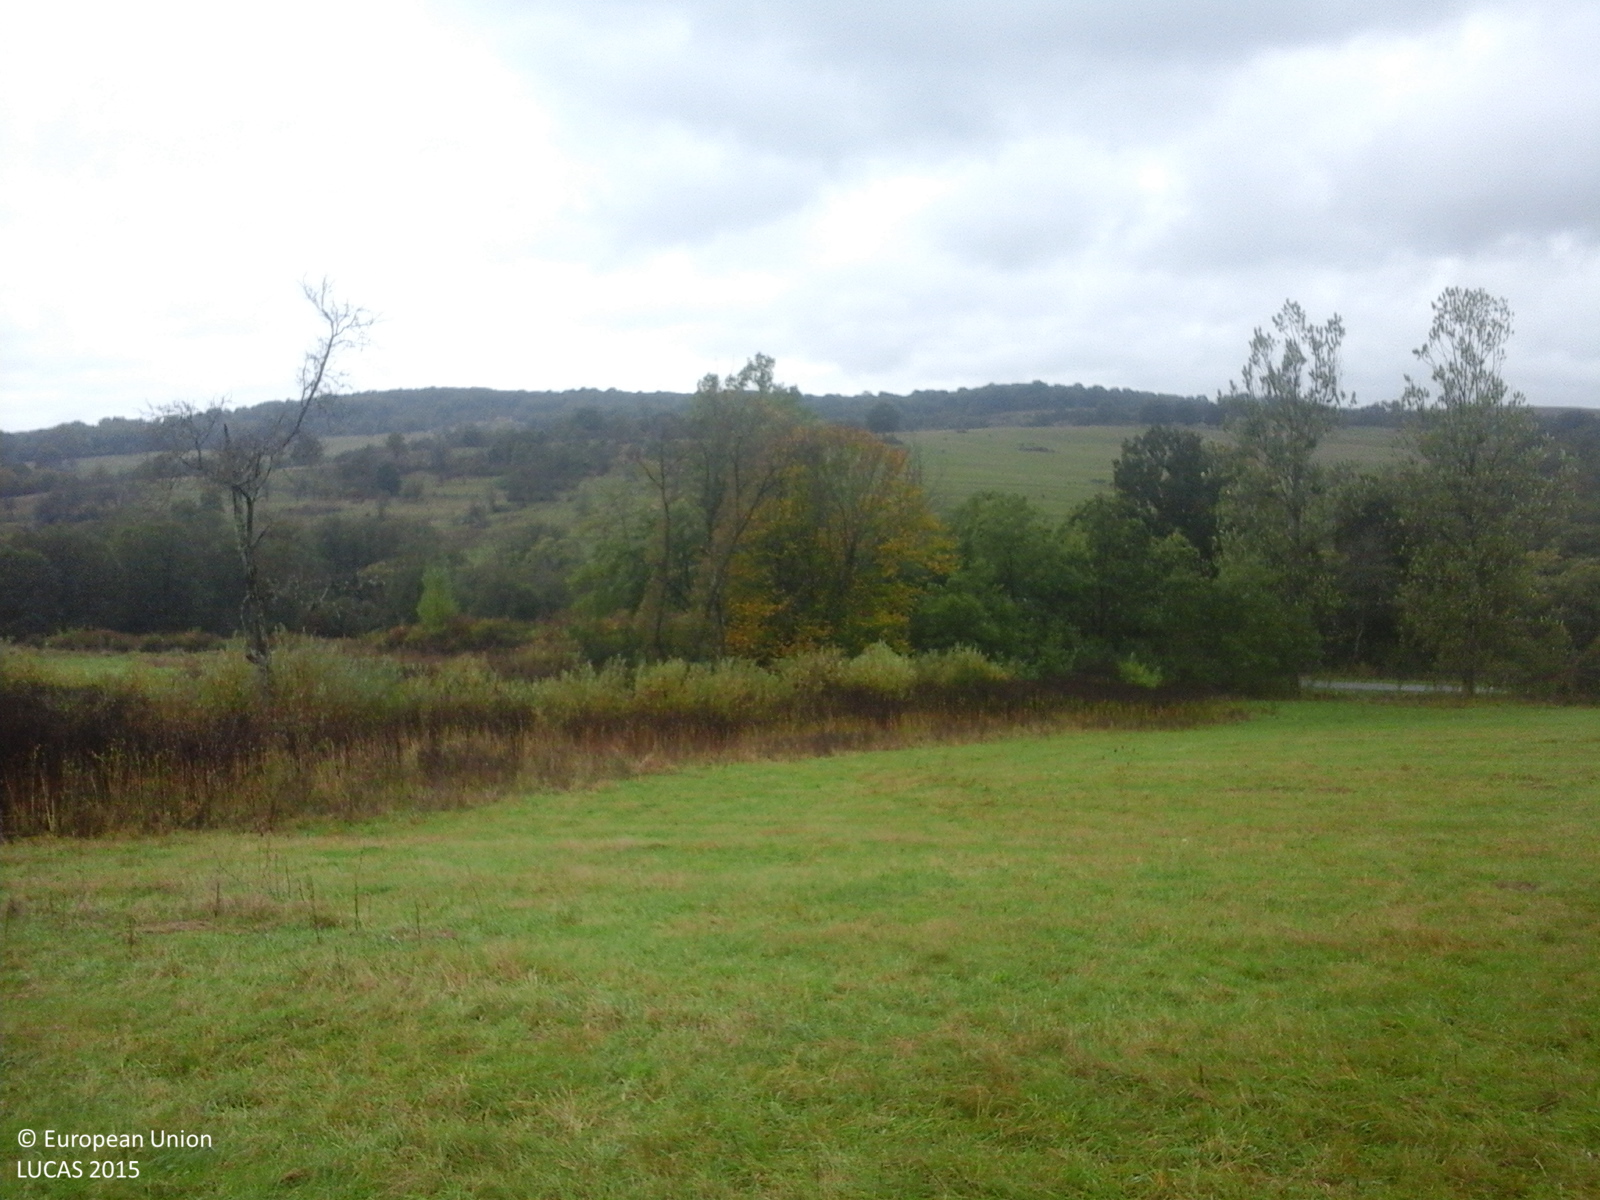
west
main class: Grassland
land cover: Grassland without tree/shrub cover
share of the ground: > 75 %
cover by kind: herbaceous plants 100 %
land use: Agriculture (excluding fallow land and kitchen gardens)
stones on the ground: < 10 %
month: October
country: RO
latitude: 45.8305
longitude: 24.6445
